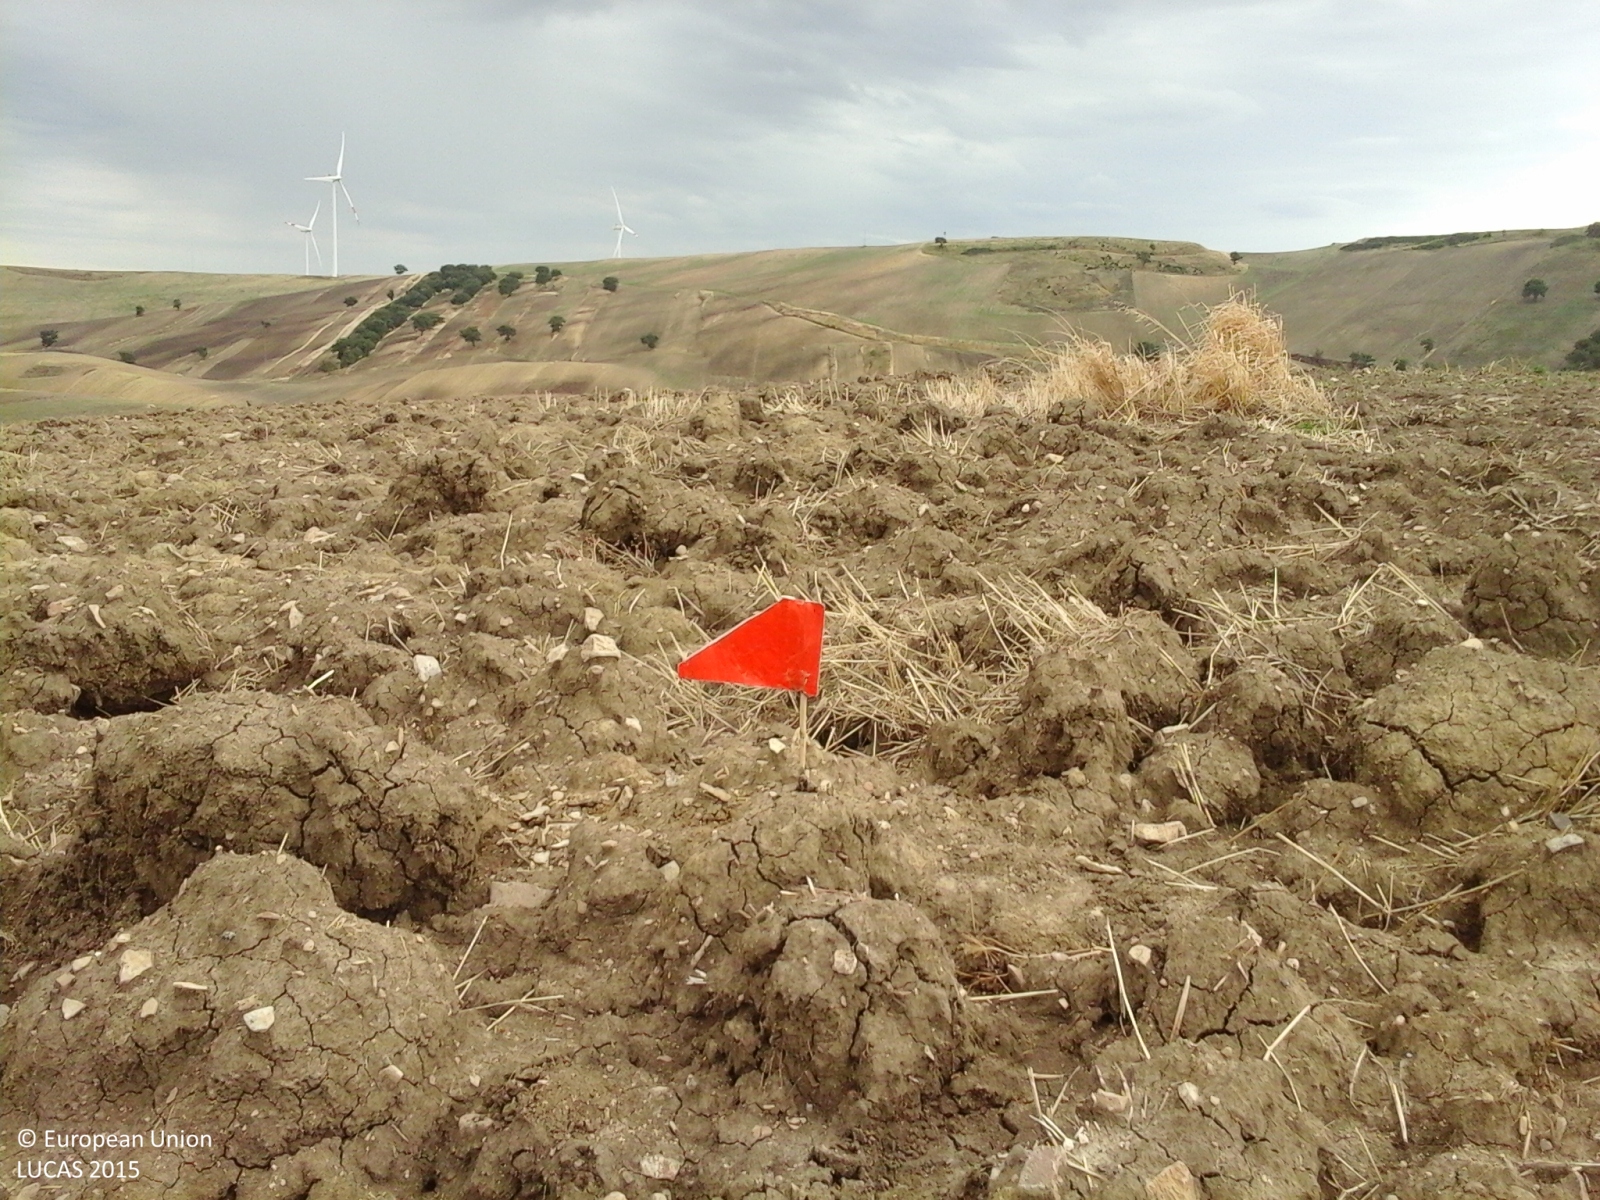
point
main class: Cropland
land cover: Durum wheat
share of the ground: > 75 %
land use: Agriculture (excluding fallow land and kitchen gardens)
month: October
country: IT
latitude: 41.5275
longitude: 15.1481
